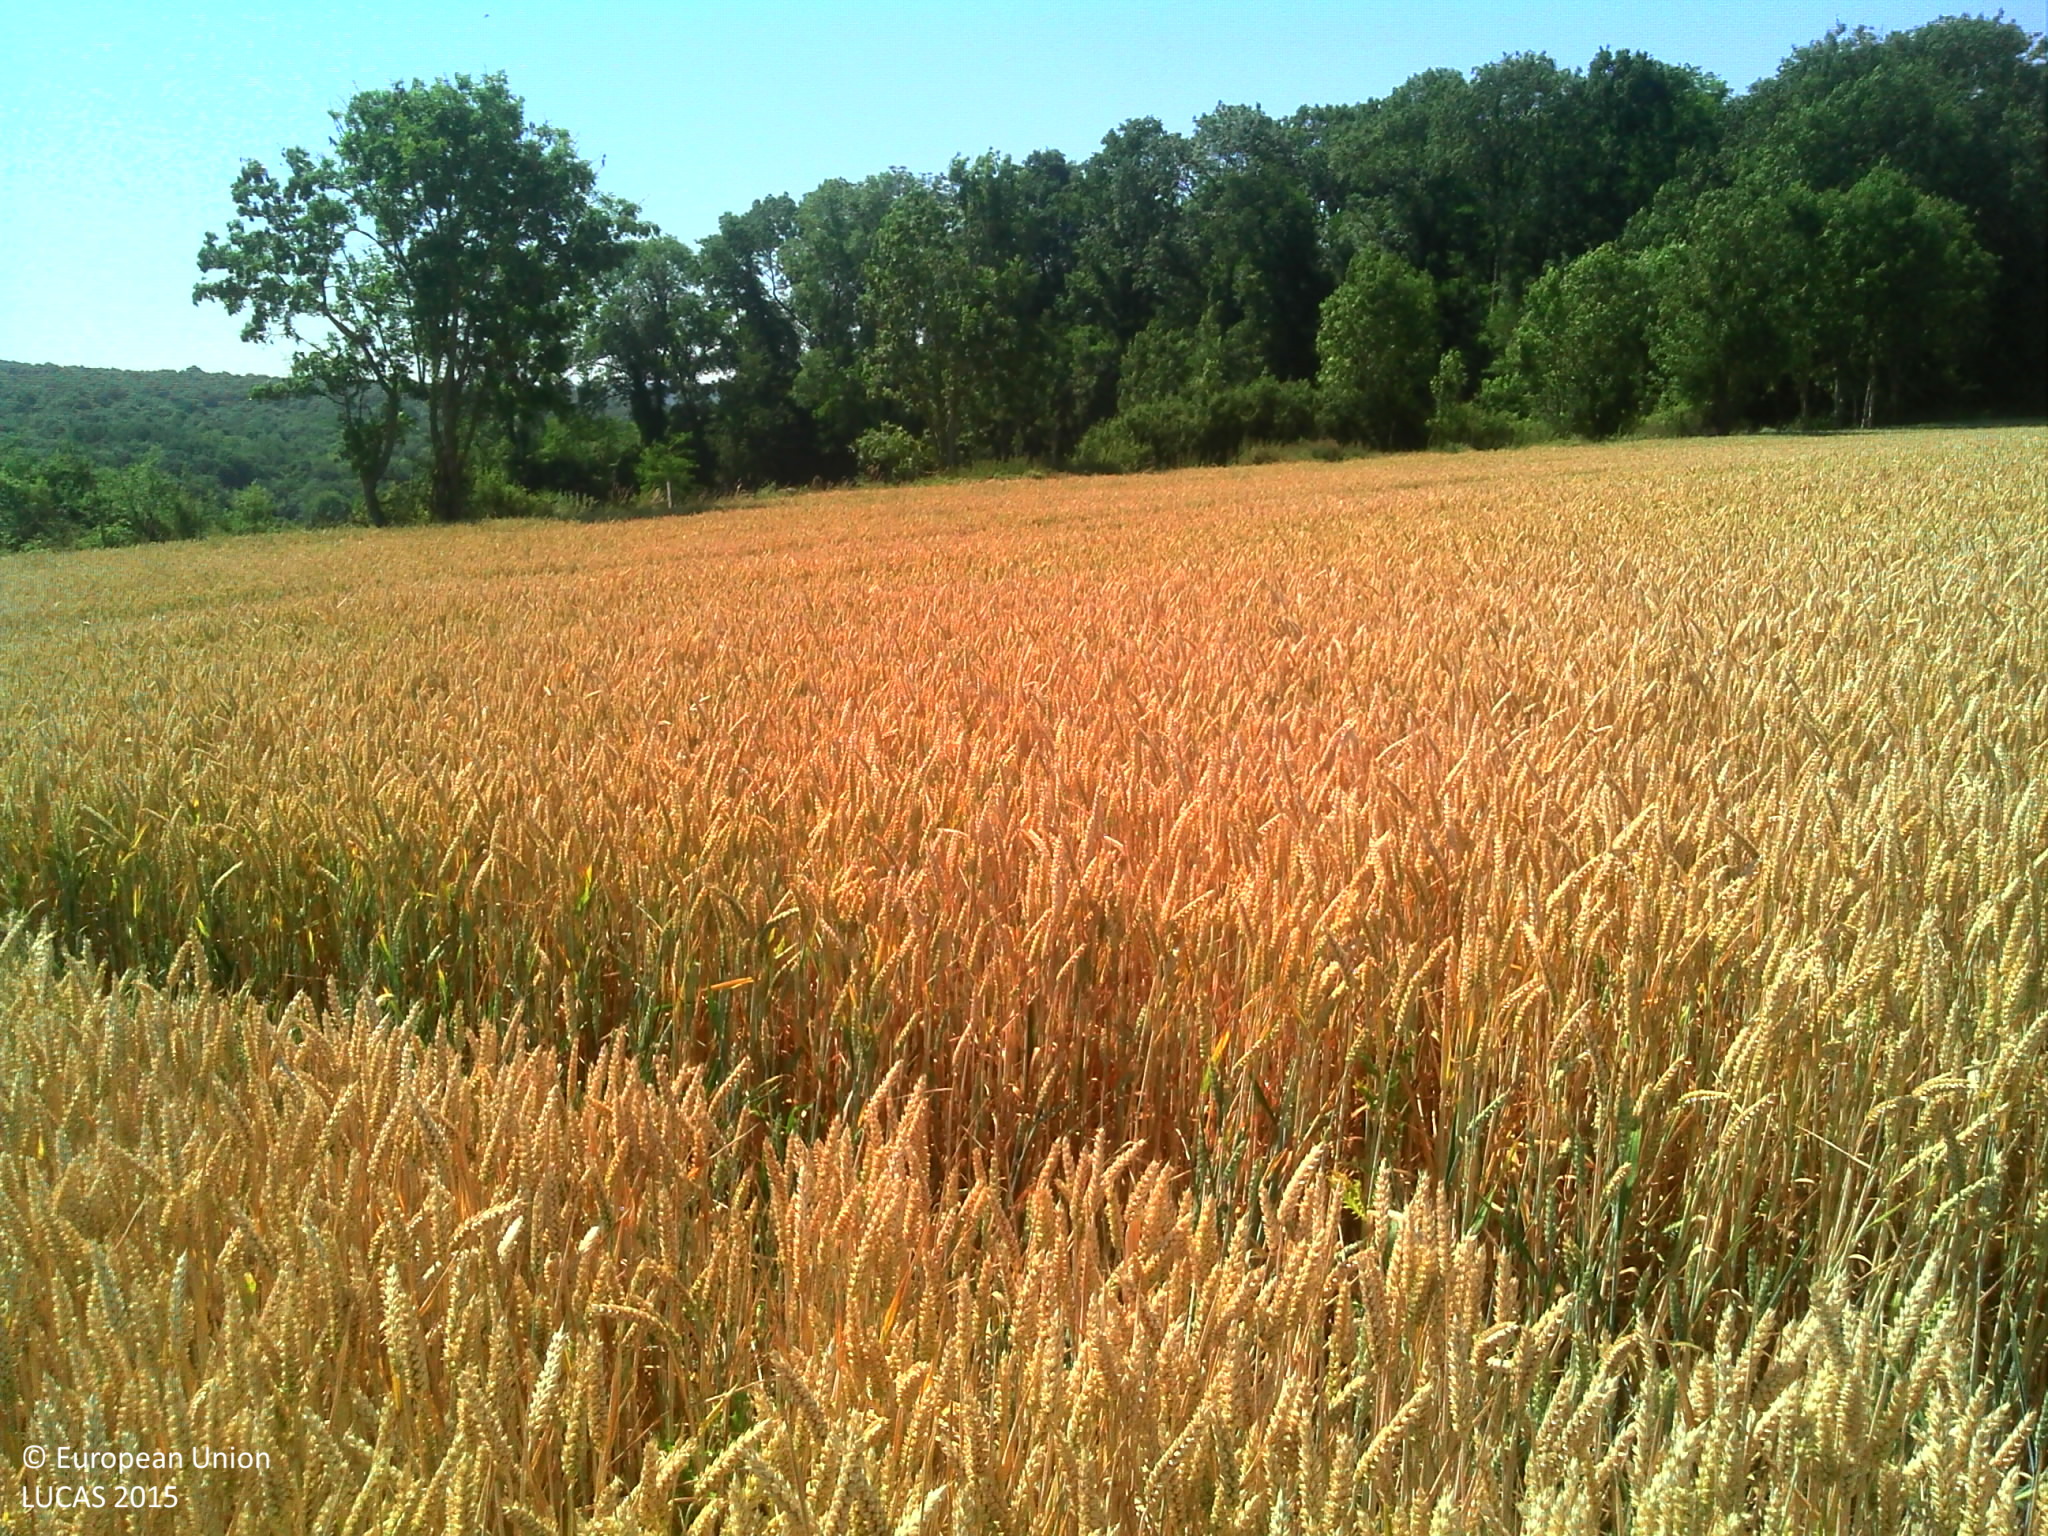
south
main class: Cropland
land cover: Common wheat
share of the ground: > 75 %
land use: Agriculture (excluding fallow land and kitchen gardens)
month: July
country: FR
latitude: 48.9951
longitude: 3.3091
